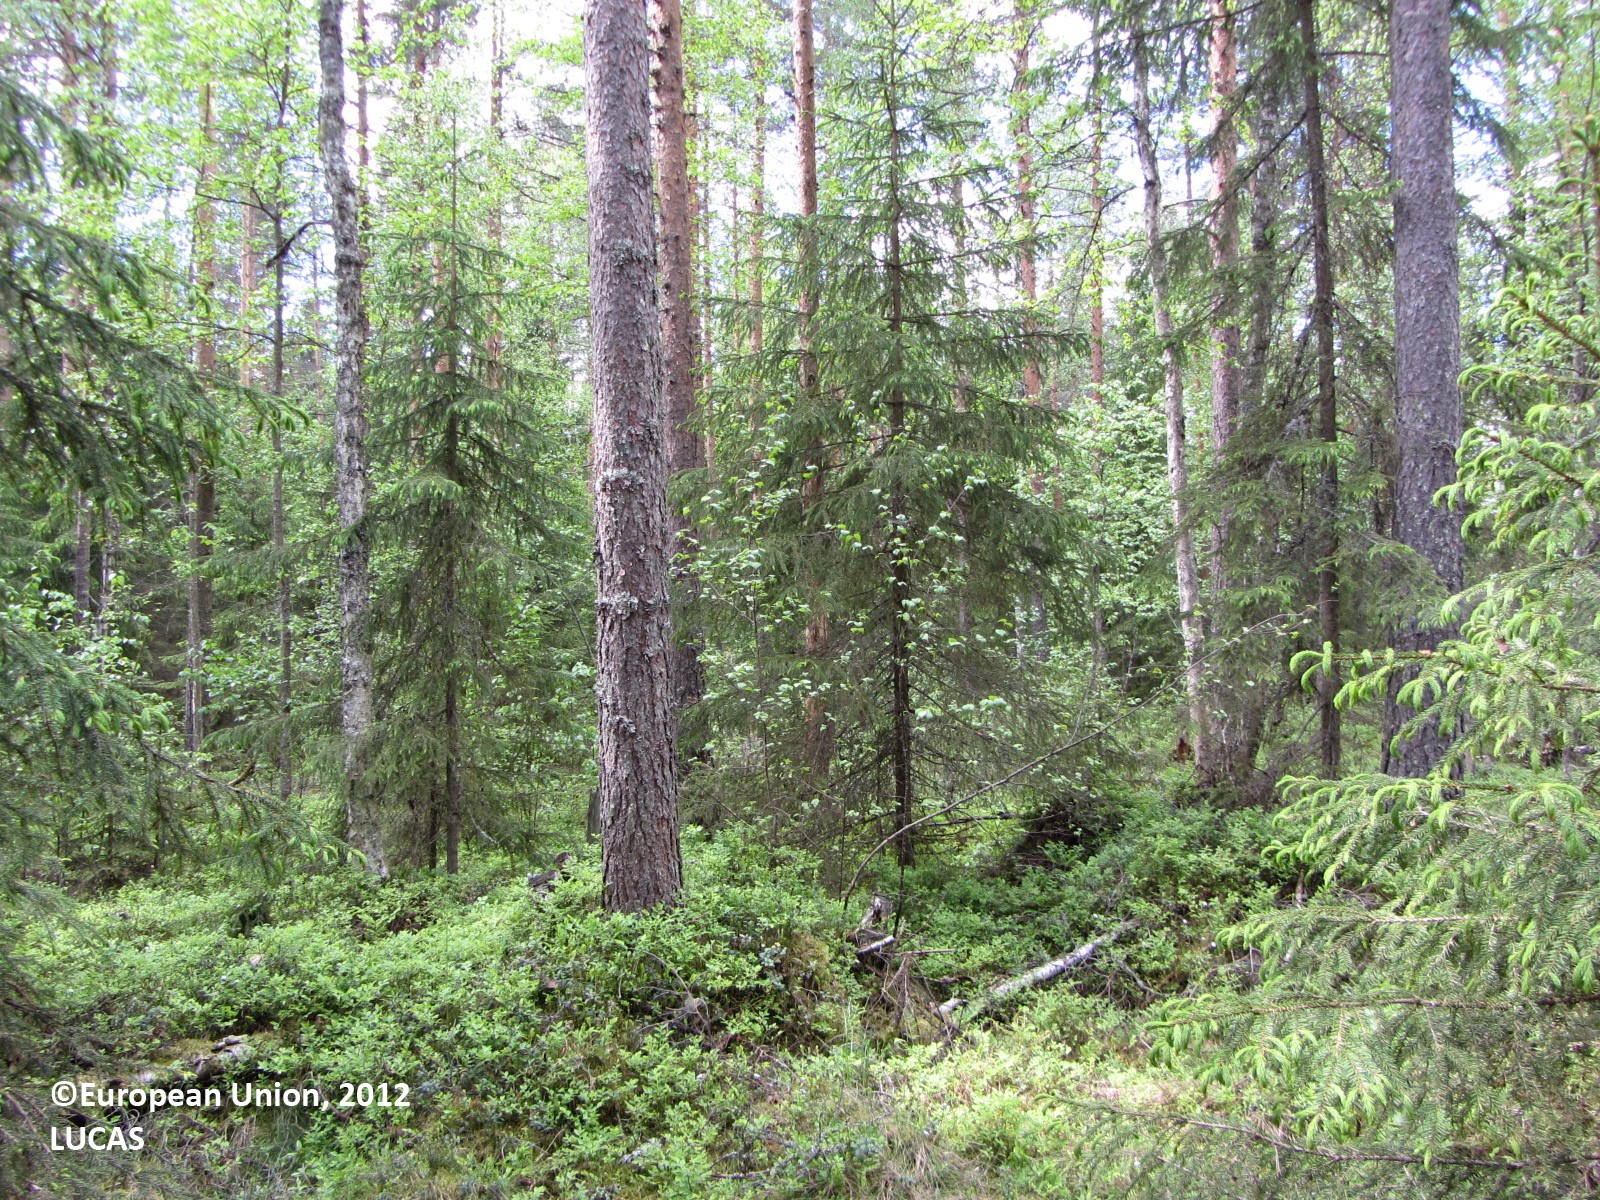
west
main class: Woodland
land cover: Other coniferous woodland
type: boreal forest
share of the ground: > 75 %
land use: Forestry
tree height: > 5 m
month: June
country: FI
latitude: 61.9300
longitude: 24.9834
